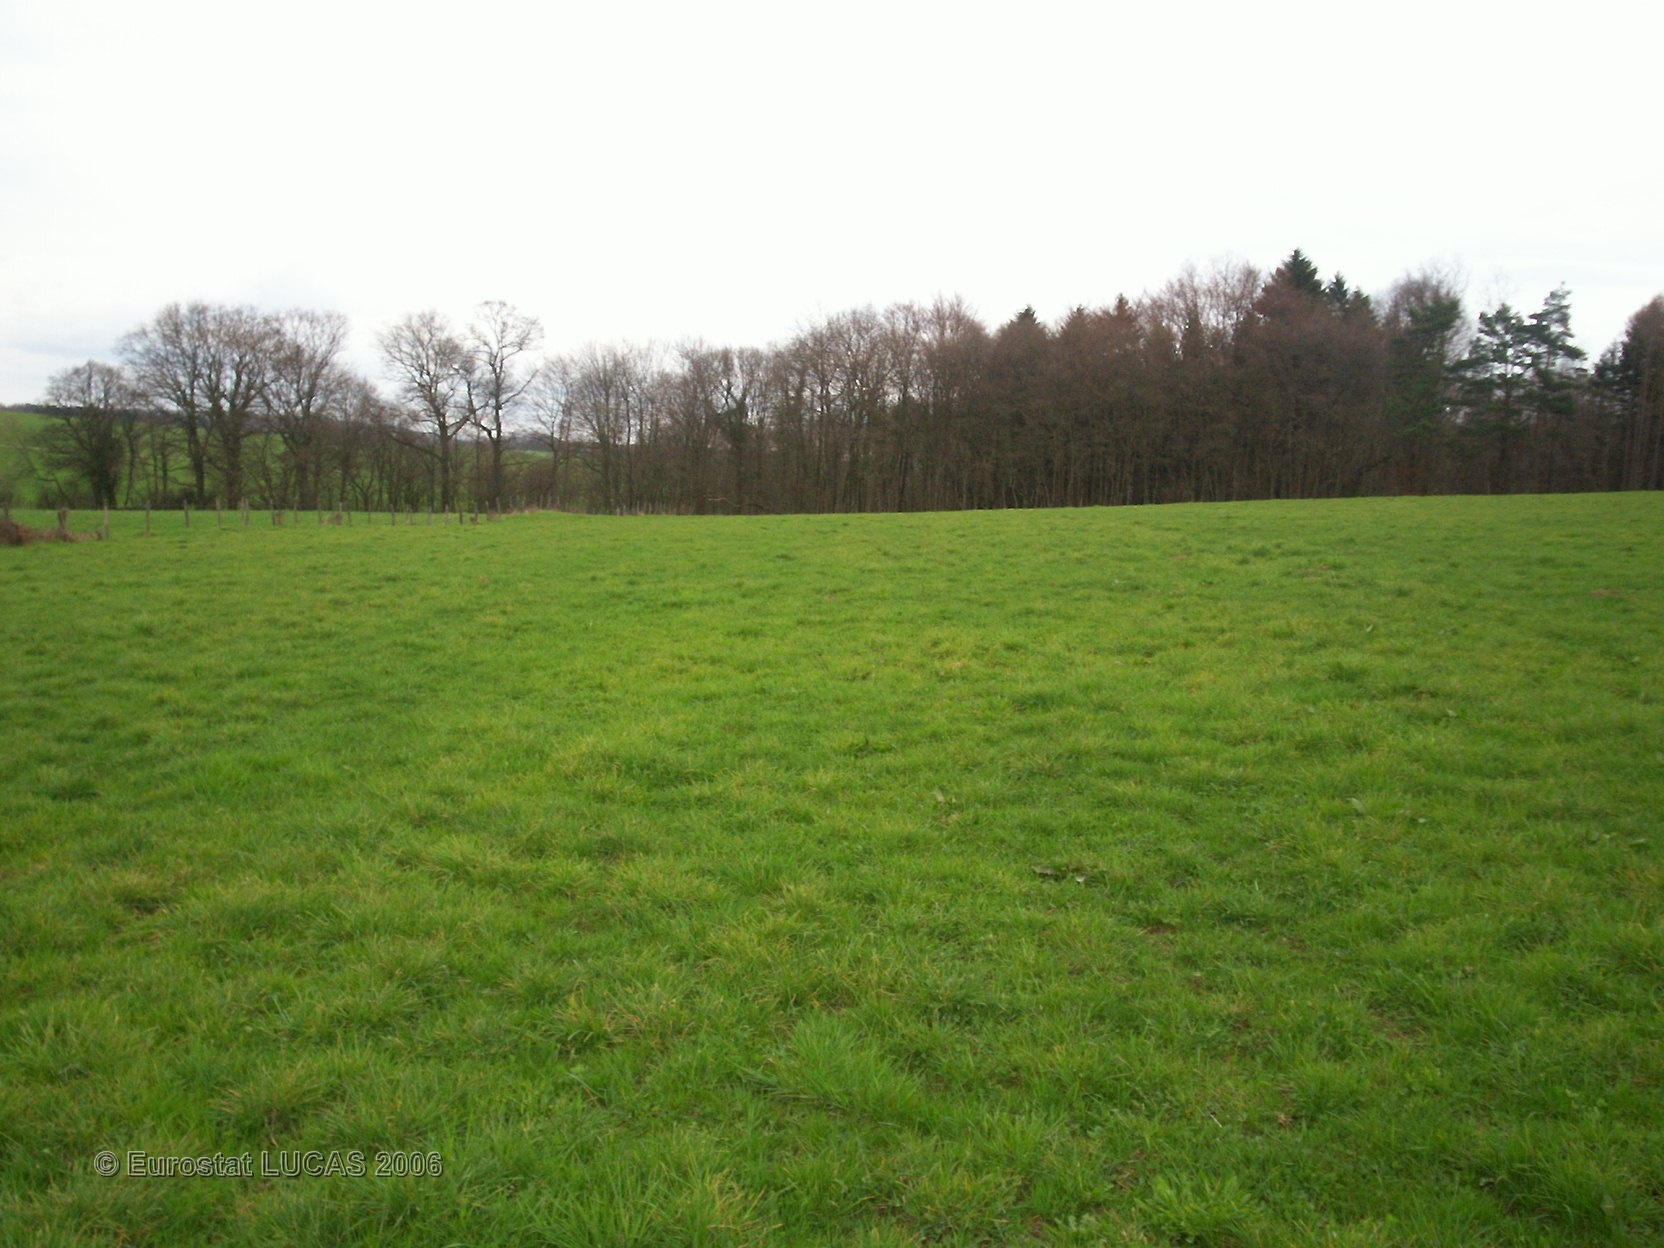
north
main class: Grassland
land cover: Grassland without tree/shrub cover
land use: Agriculture (excluding fallow land and kitchen gardens)
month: April
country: FR
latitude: 47.4880
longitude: 6.6438
